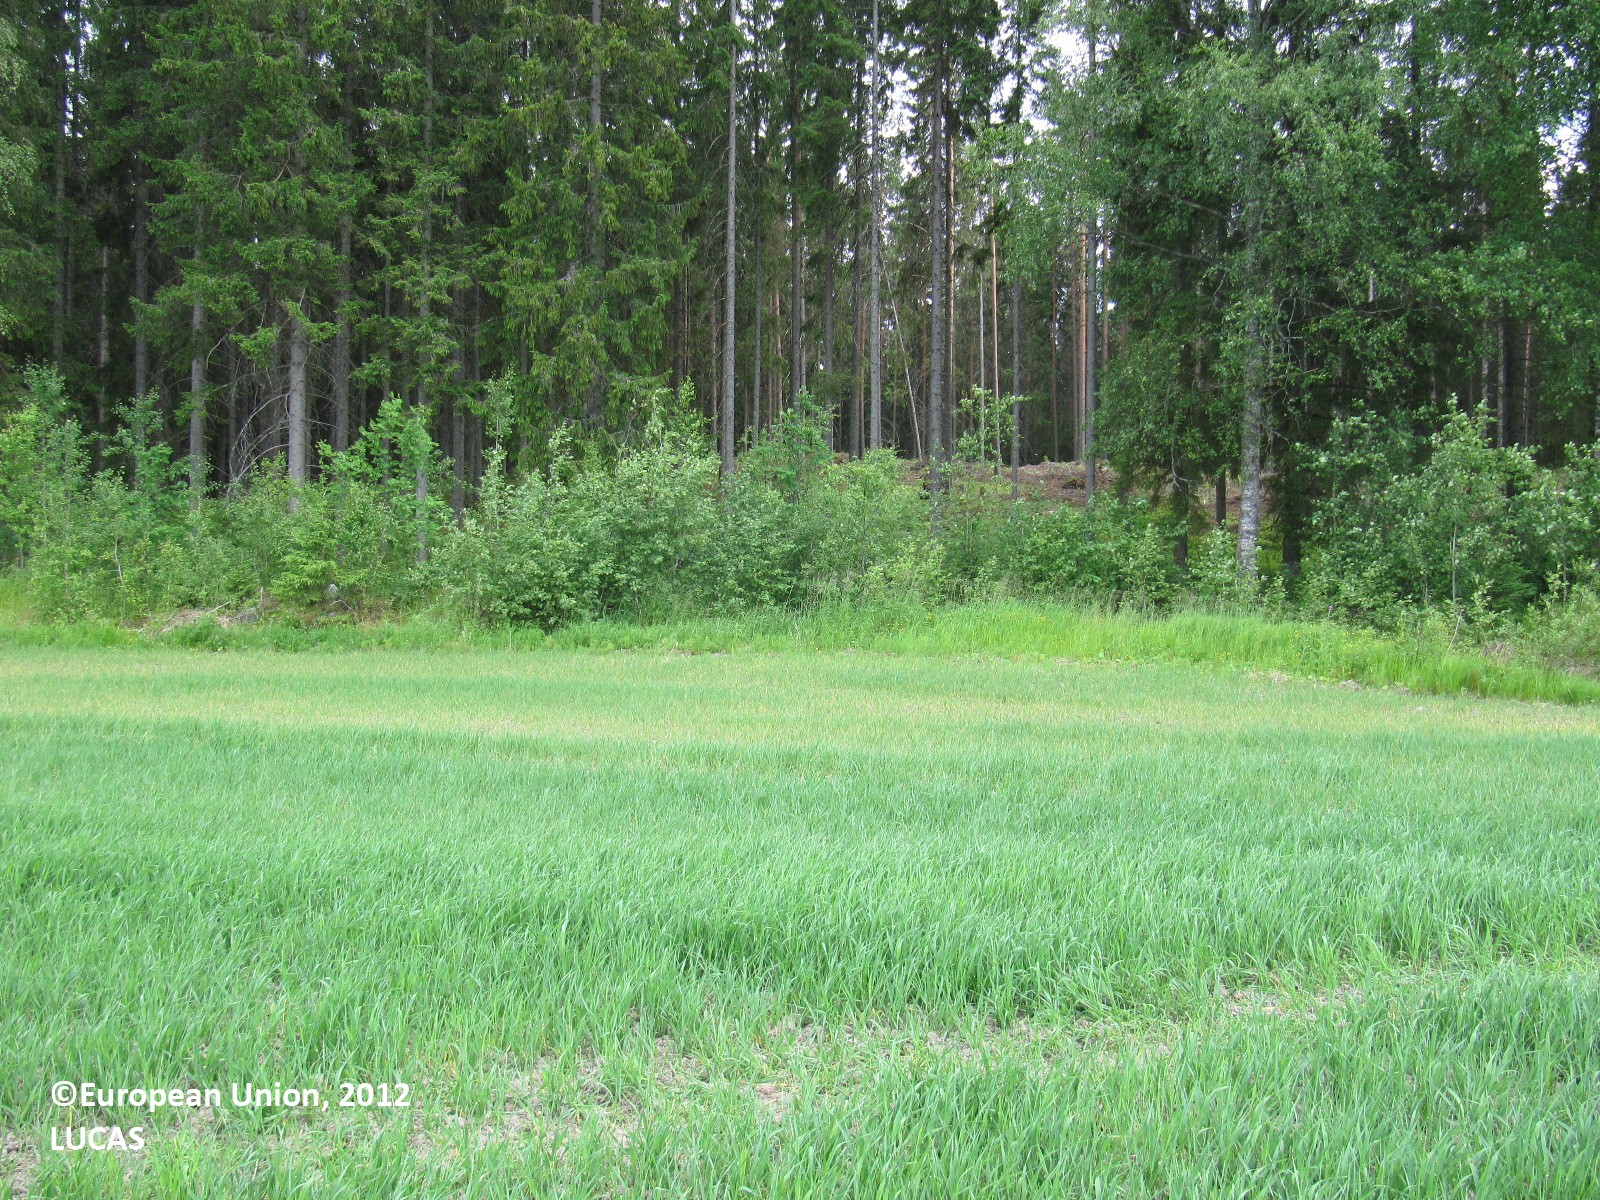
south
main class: Cropland
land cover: Barley
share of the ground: > 75 %
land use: Agriculture (excluding fallow land and kitchen gardens)
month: July
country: FI
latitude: 60.8562
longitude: 23.3911
